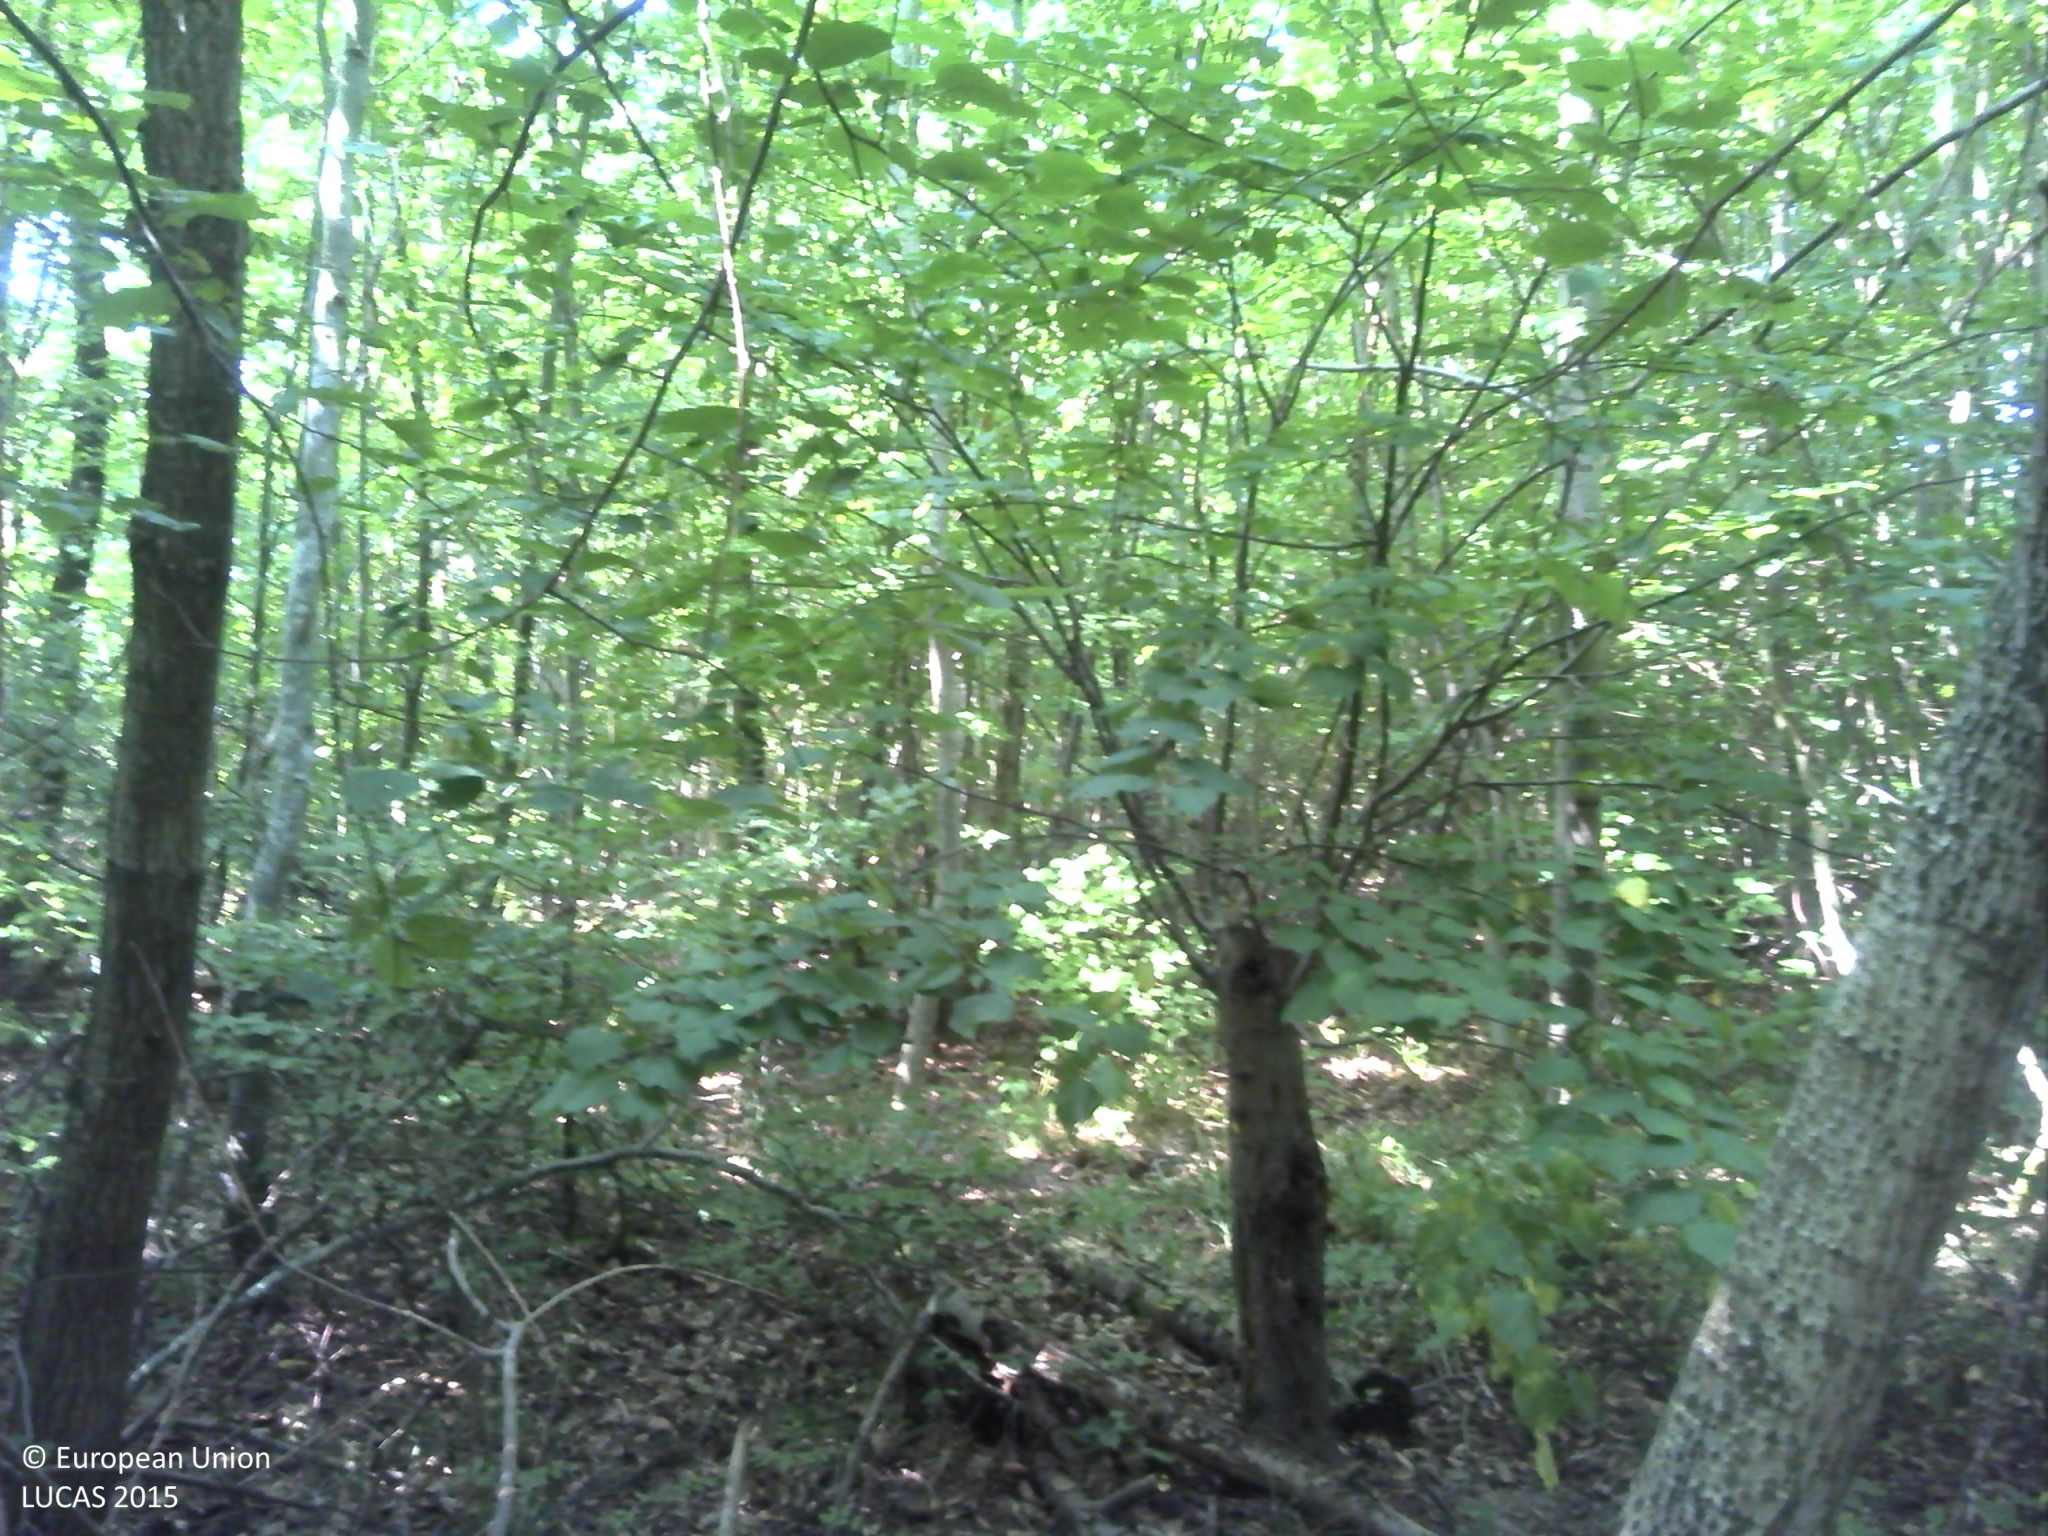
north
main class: Woodland
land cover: Broadleaved woodland
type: acidophilous oak and oak-birch forest
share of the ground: > 75 %
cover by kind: broadleaved forest trees 100 %
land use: Forestry
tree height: > 5 m
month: July
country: FR
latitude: 48.8261
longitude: 6.8266
